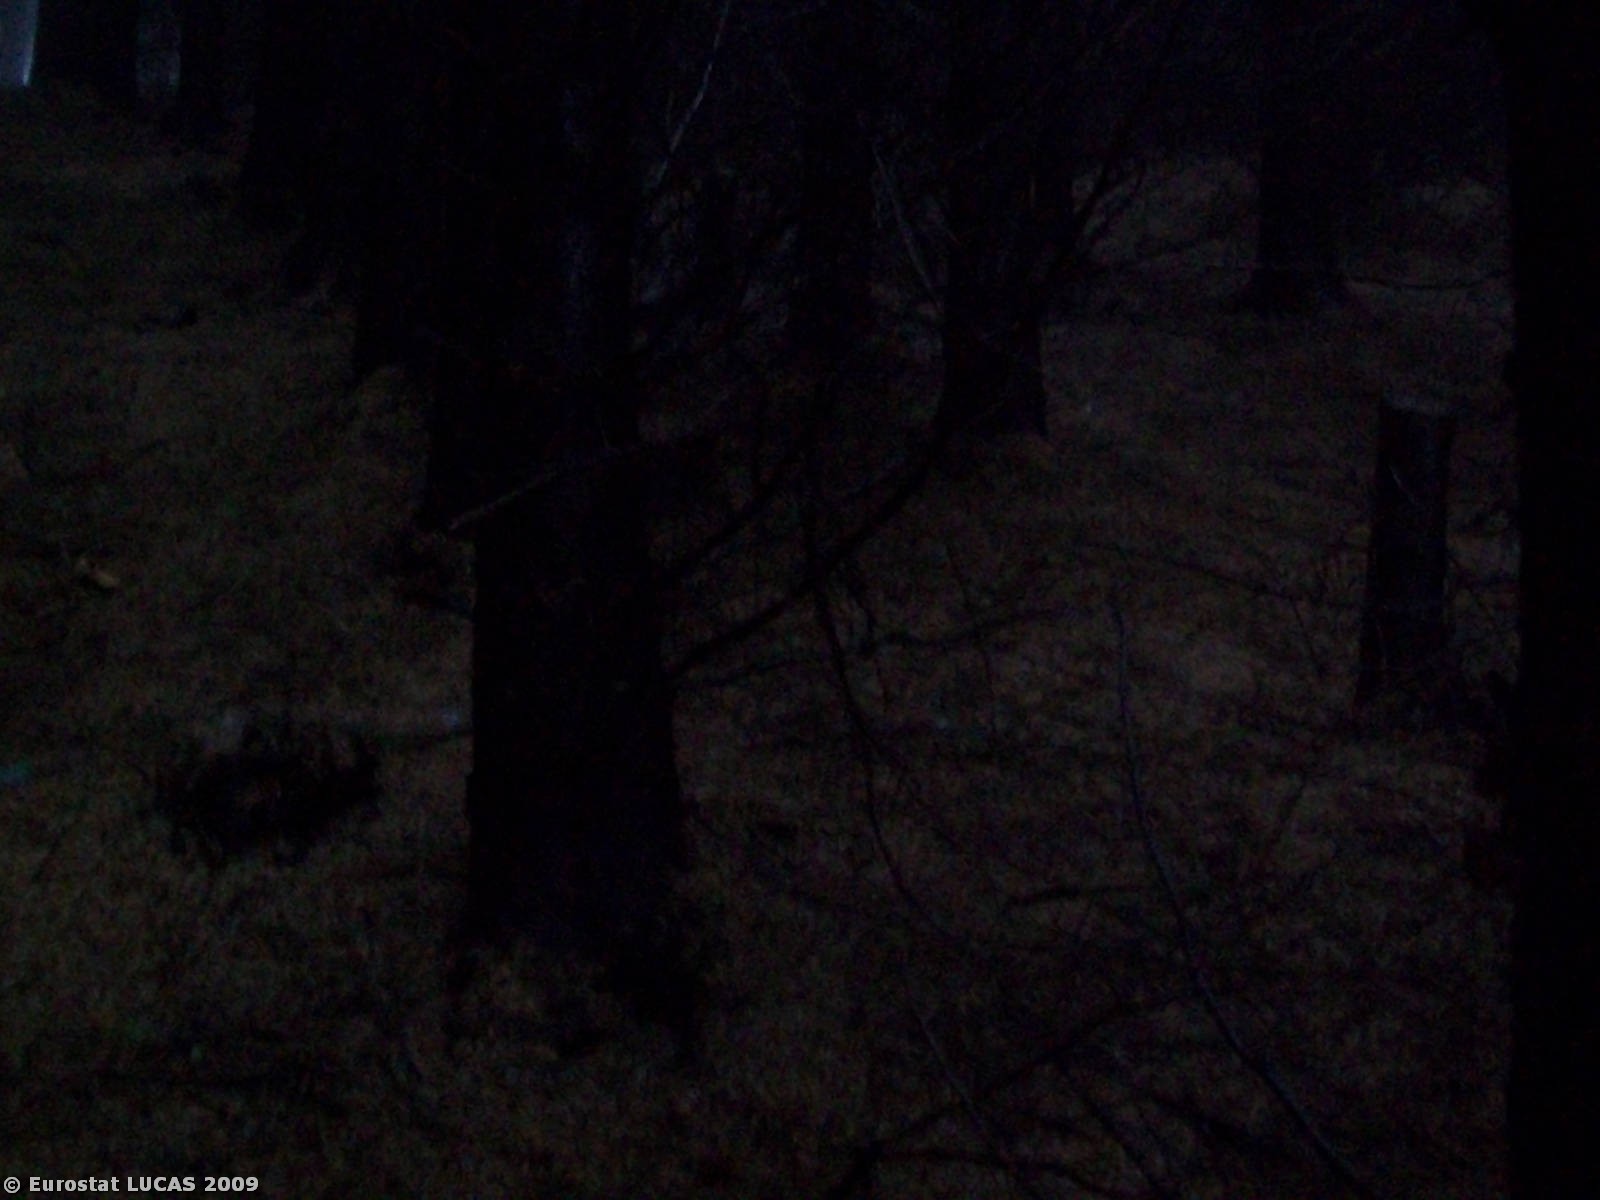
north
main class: Woodland
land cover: Coniferous woodland
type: plantations and self-sown exotic forest
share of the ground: > 75 %
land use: Forestry
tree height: > 5 m
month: July
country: GB
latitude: 54.7660
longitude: -6.1693
